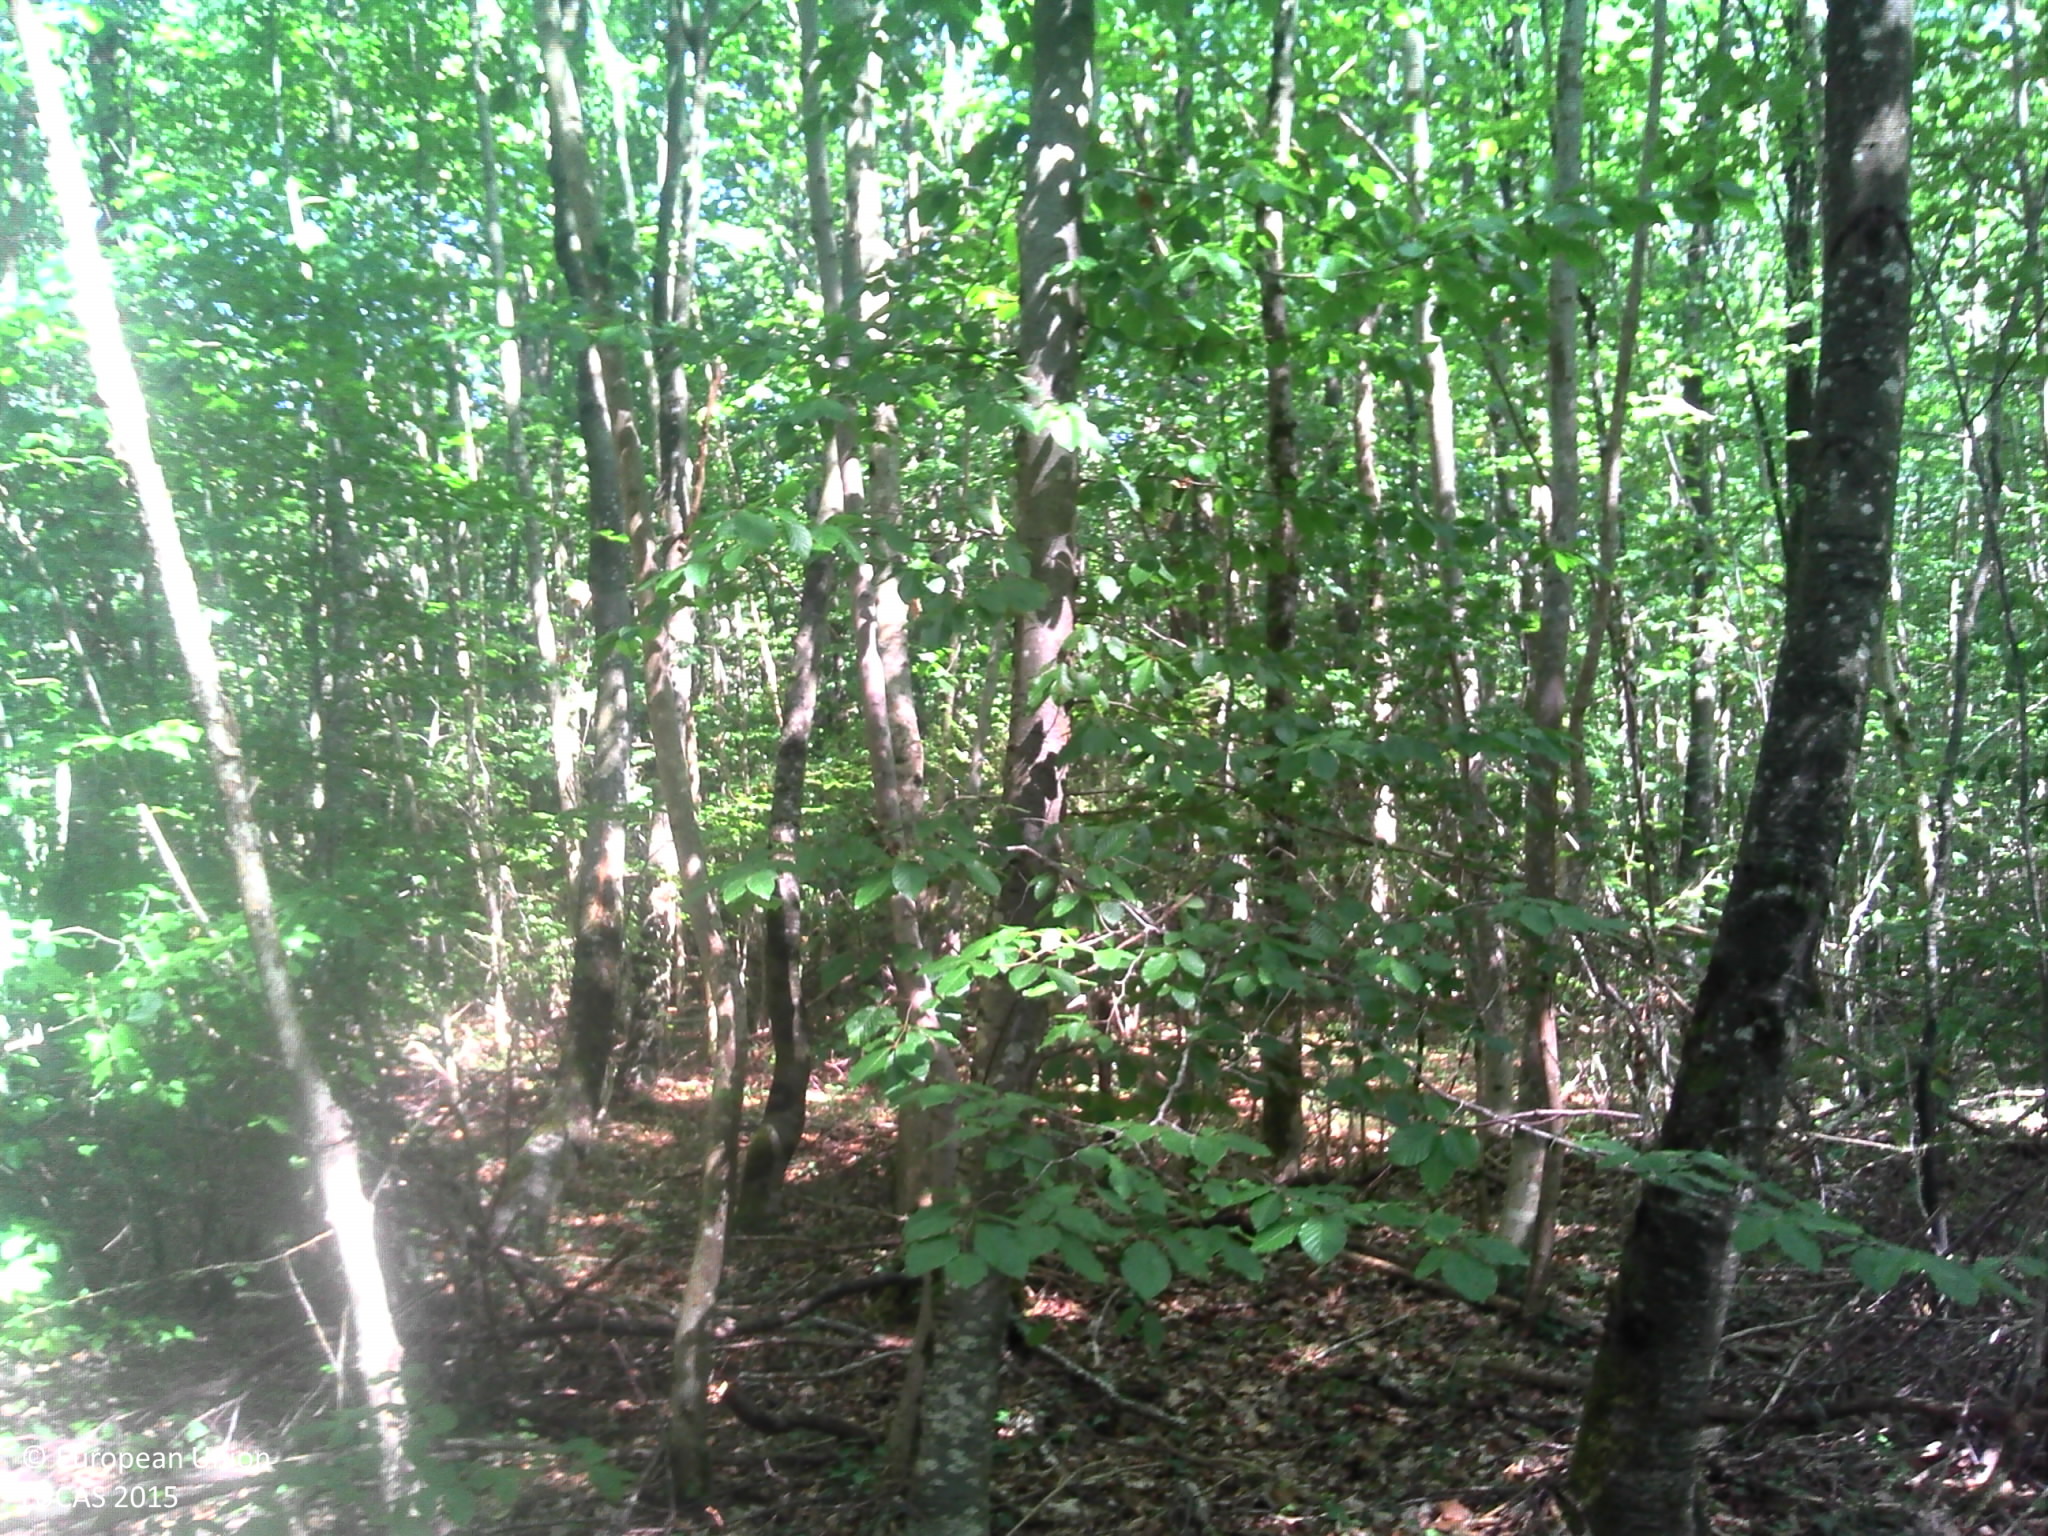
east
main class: Woodland
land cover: Broadleaved woodland
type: beech forest
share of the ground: > 75 %
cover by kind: broadleaved forest trees 90 %, herbaceous plants 5 %, lichens and mosses 5 %
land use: Forestry
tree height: > 5 m
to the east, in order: Broadleaved woodland; Tracks; Broadleaved woodland; Tracks; Broadleaved woodland
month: August
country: FR
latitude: 47.7734
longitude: 5.1291
